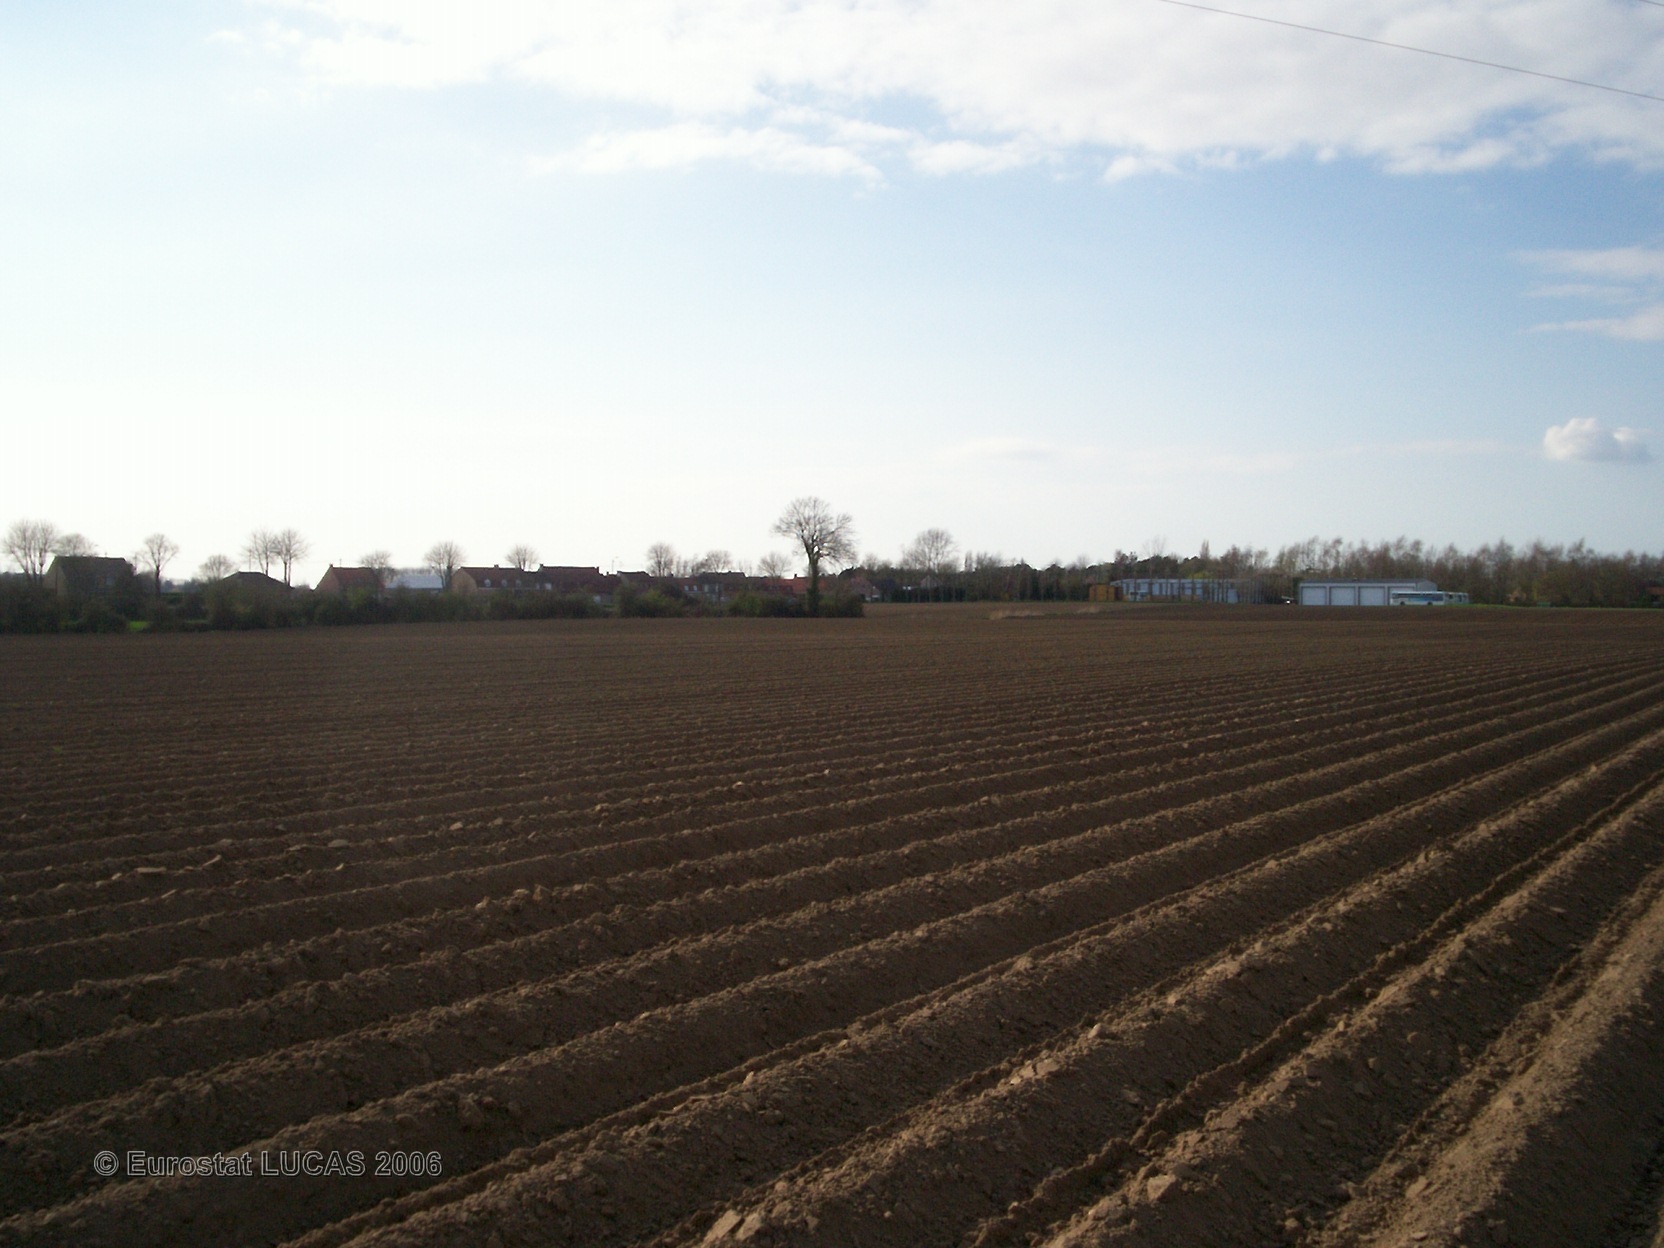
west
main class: Cropland
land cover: Potatoes
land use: Agriculture (excluding fallow land and kitchen gardens)
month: May
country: FR
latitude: 50.8920
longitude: 2.4664
